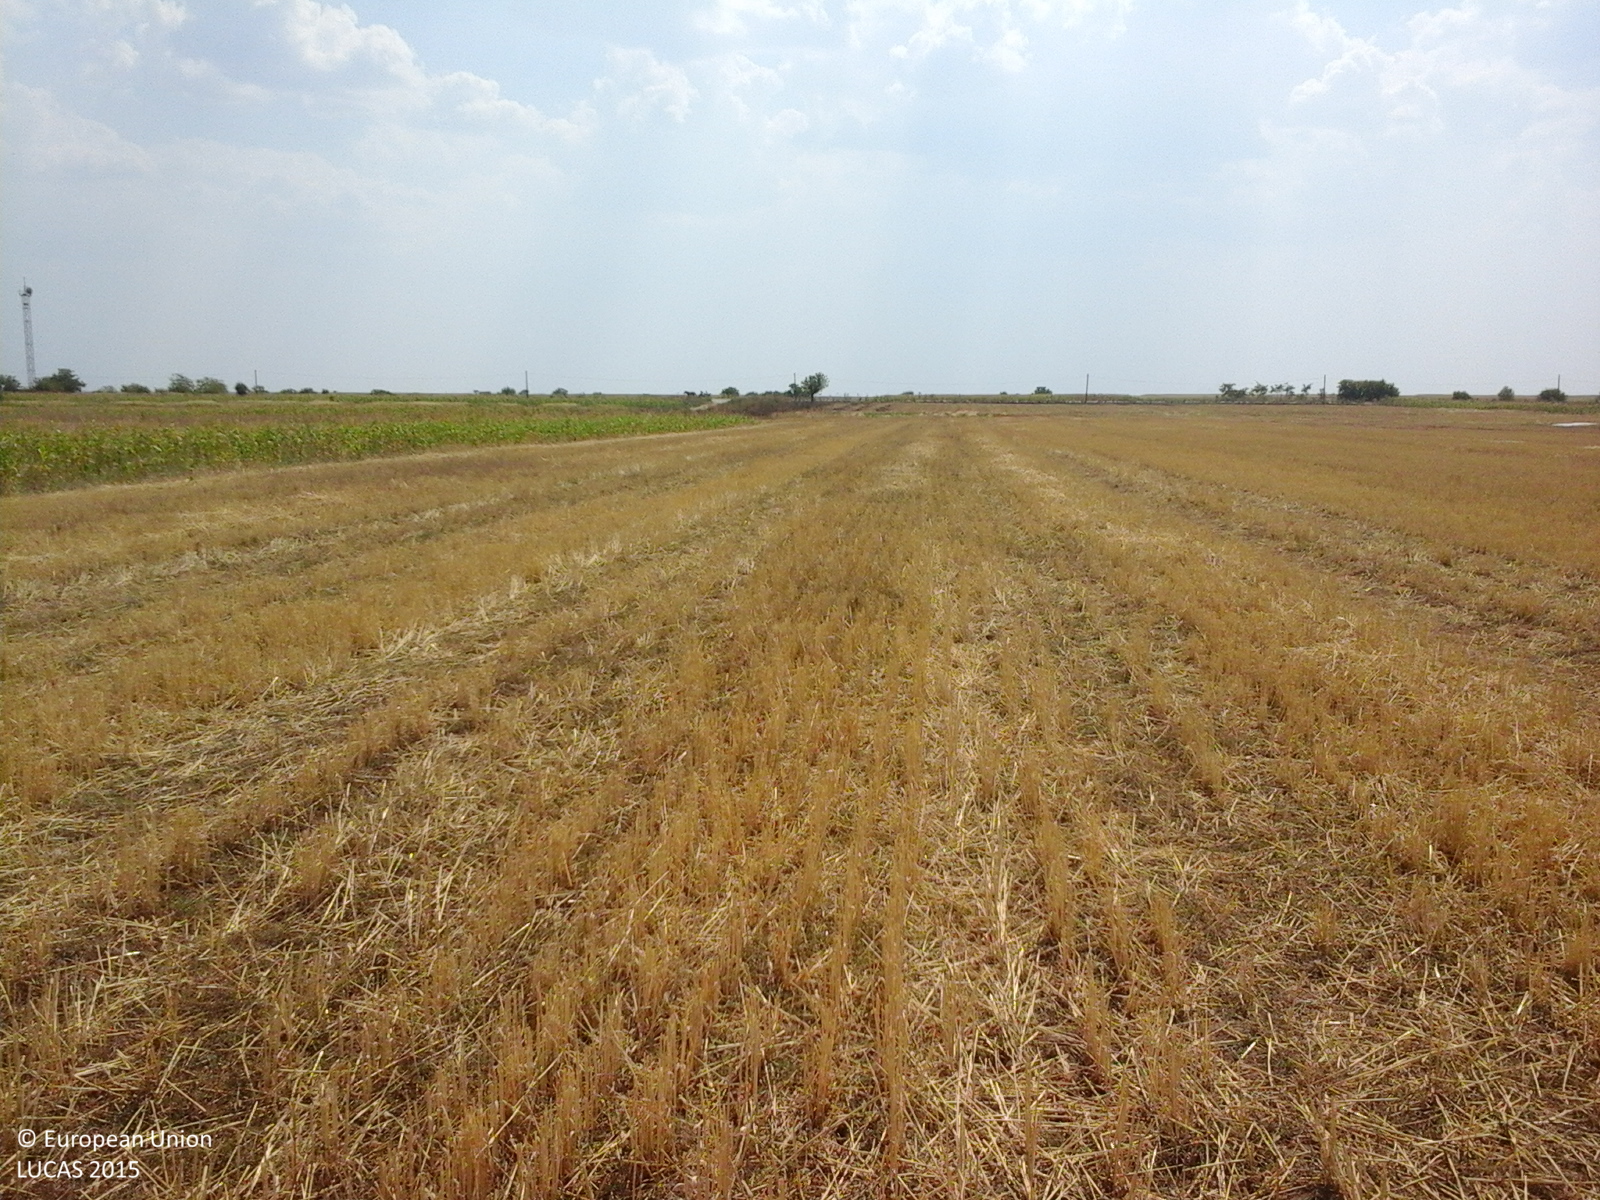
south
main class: Cropland
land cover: Durum wheat
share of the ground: > 75 %
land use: Agriculture (excluding fallow land and kitchen gardens)
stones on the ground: < 10 %
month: August
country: RO
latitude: 44.3903
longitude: 23.1145
